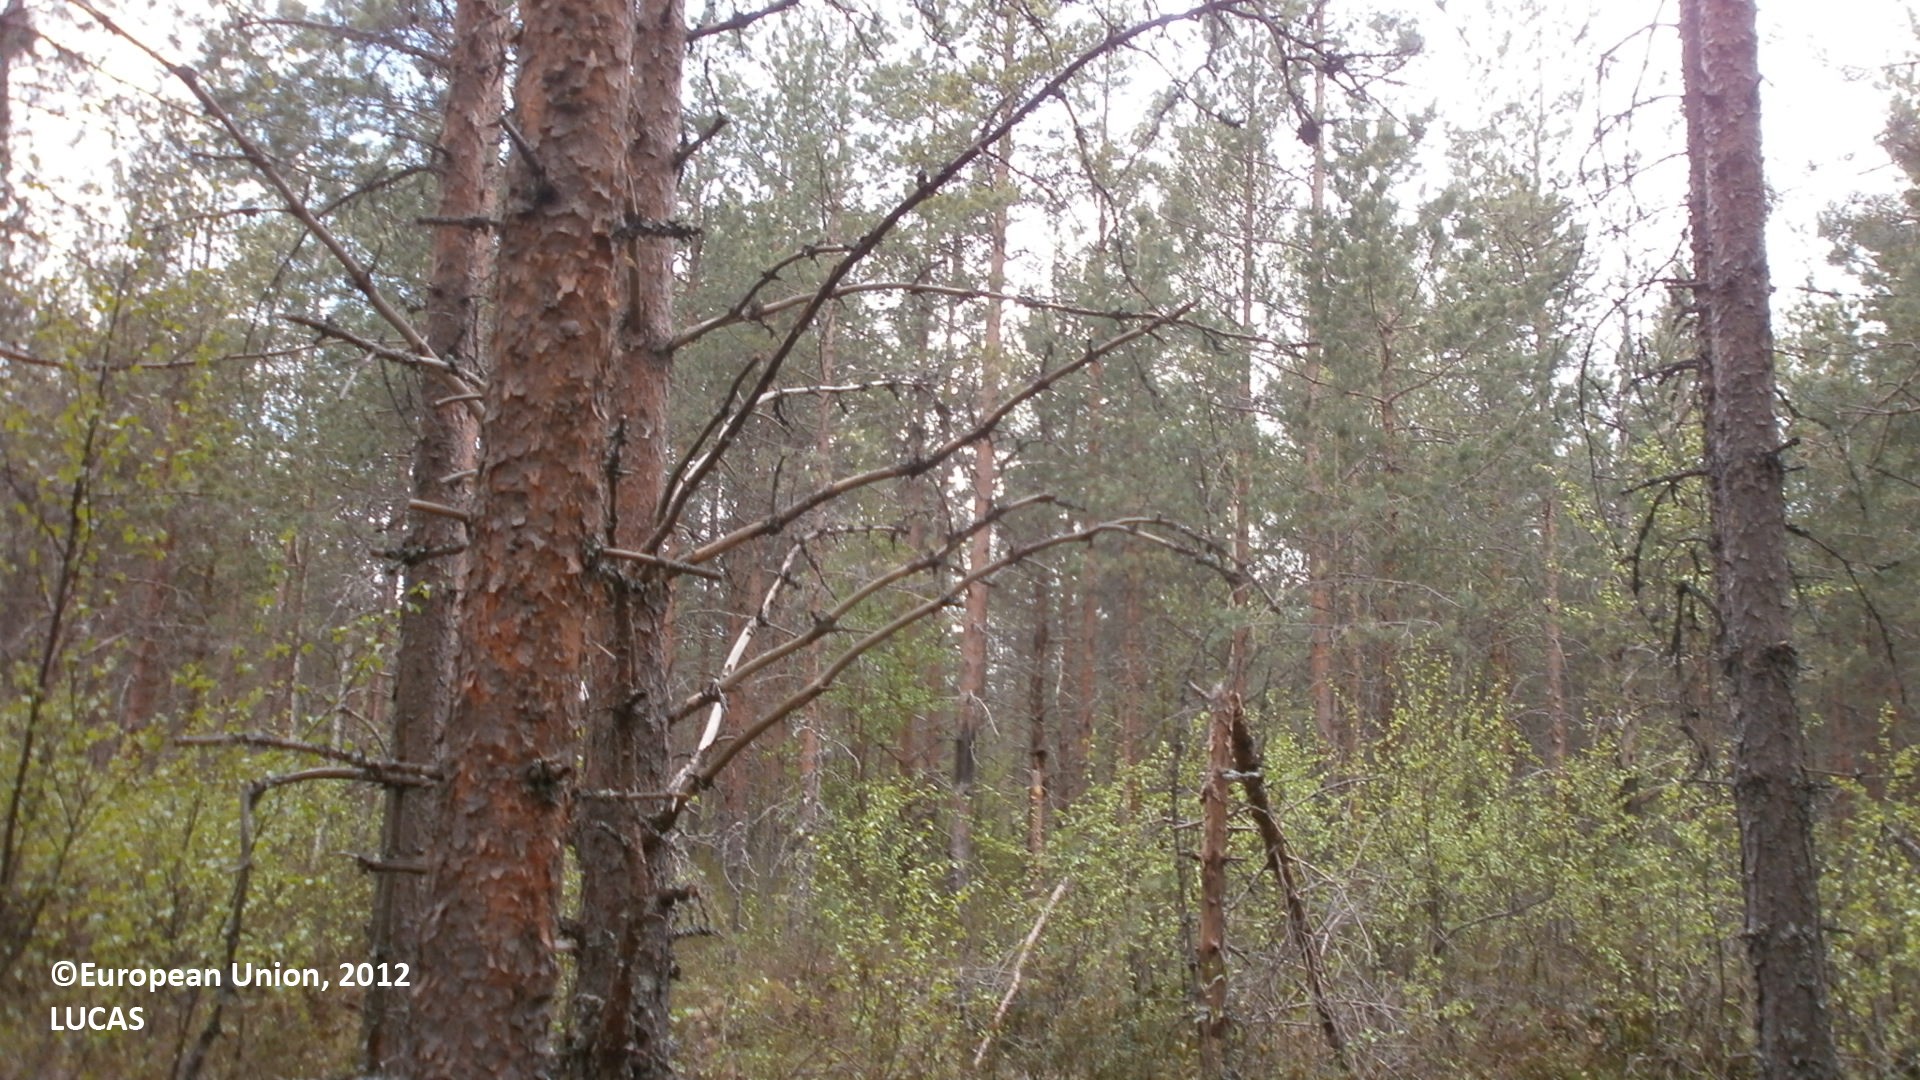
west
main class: Woodland
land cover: Pine dominated coniferous woodland
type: mire and swamp forests
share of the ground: > 75 %
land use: Forestry
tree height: > 5 m
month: May
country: FI
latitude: 64.4744
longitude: 25.9284
